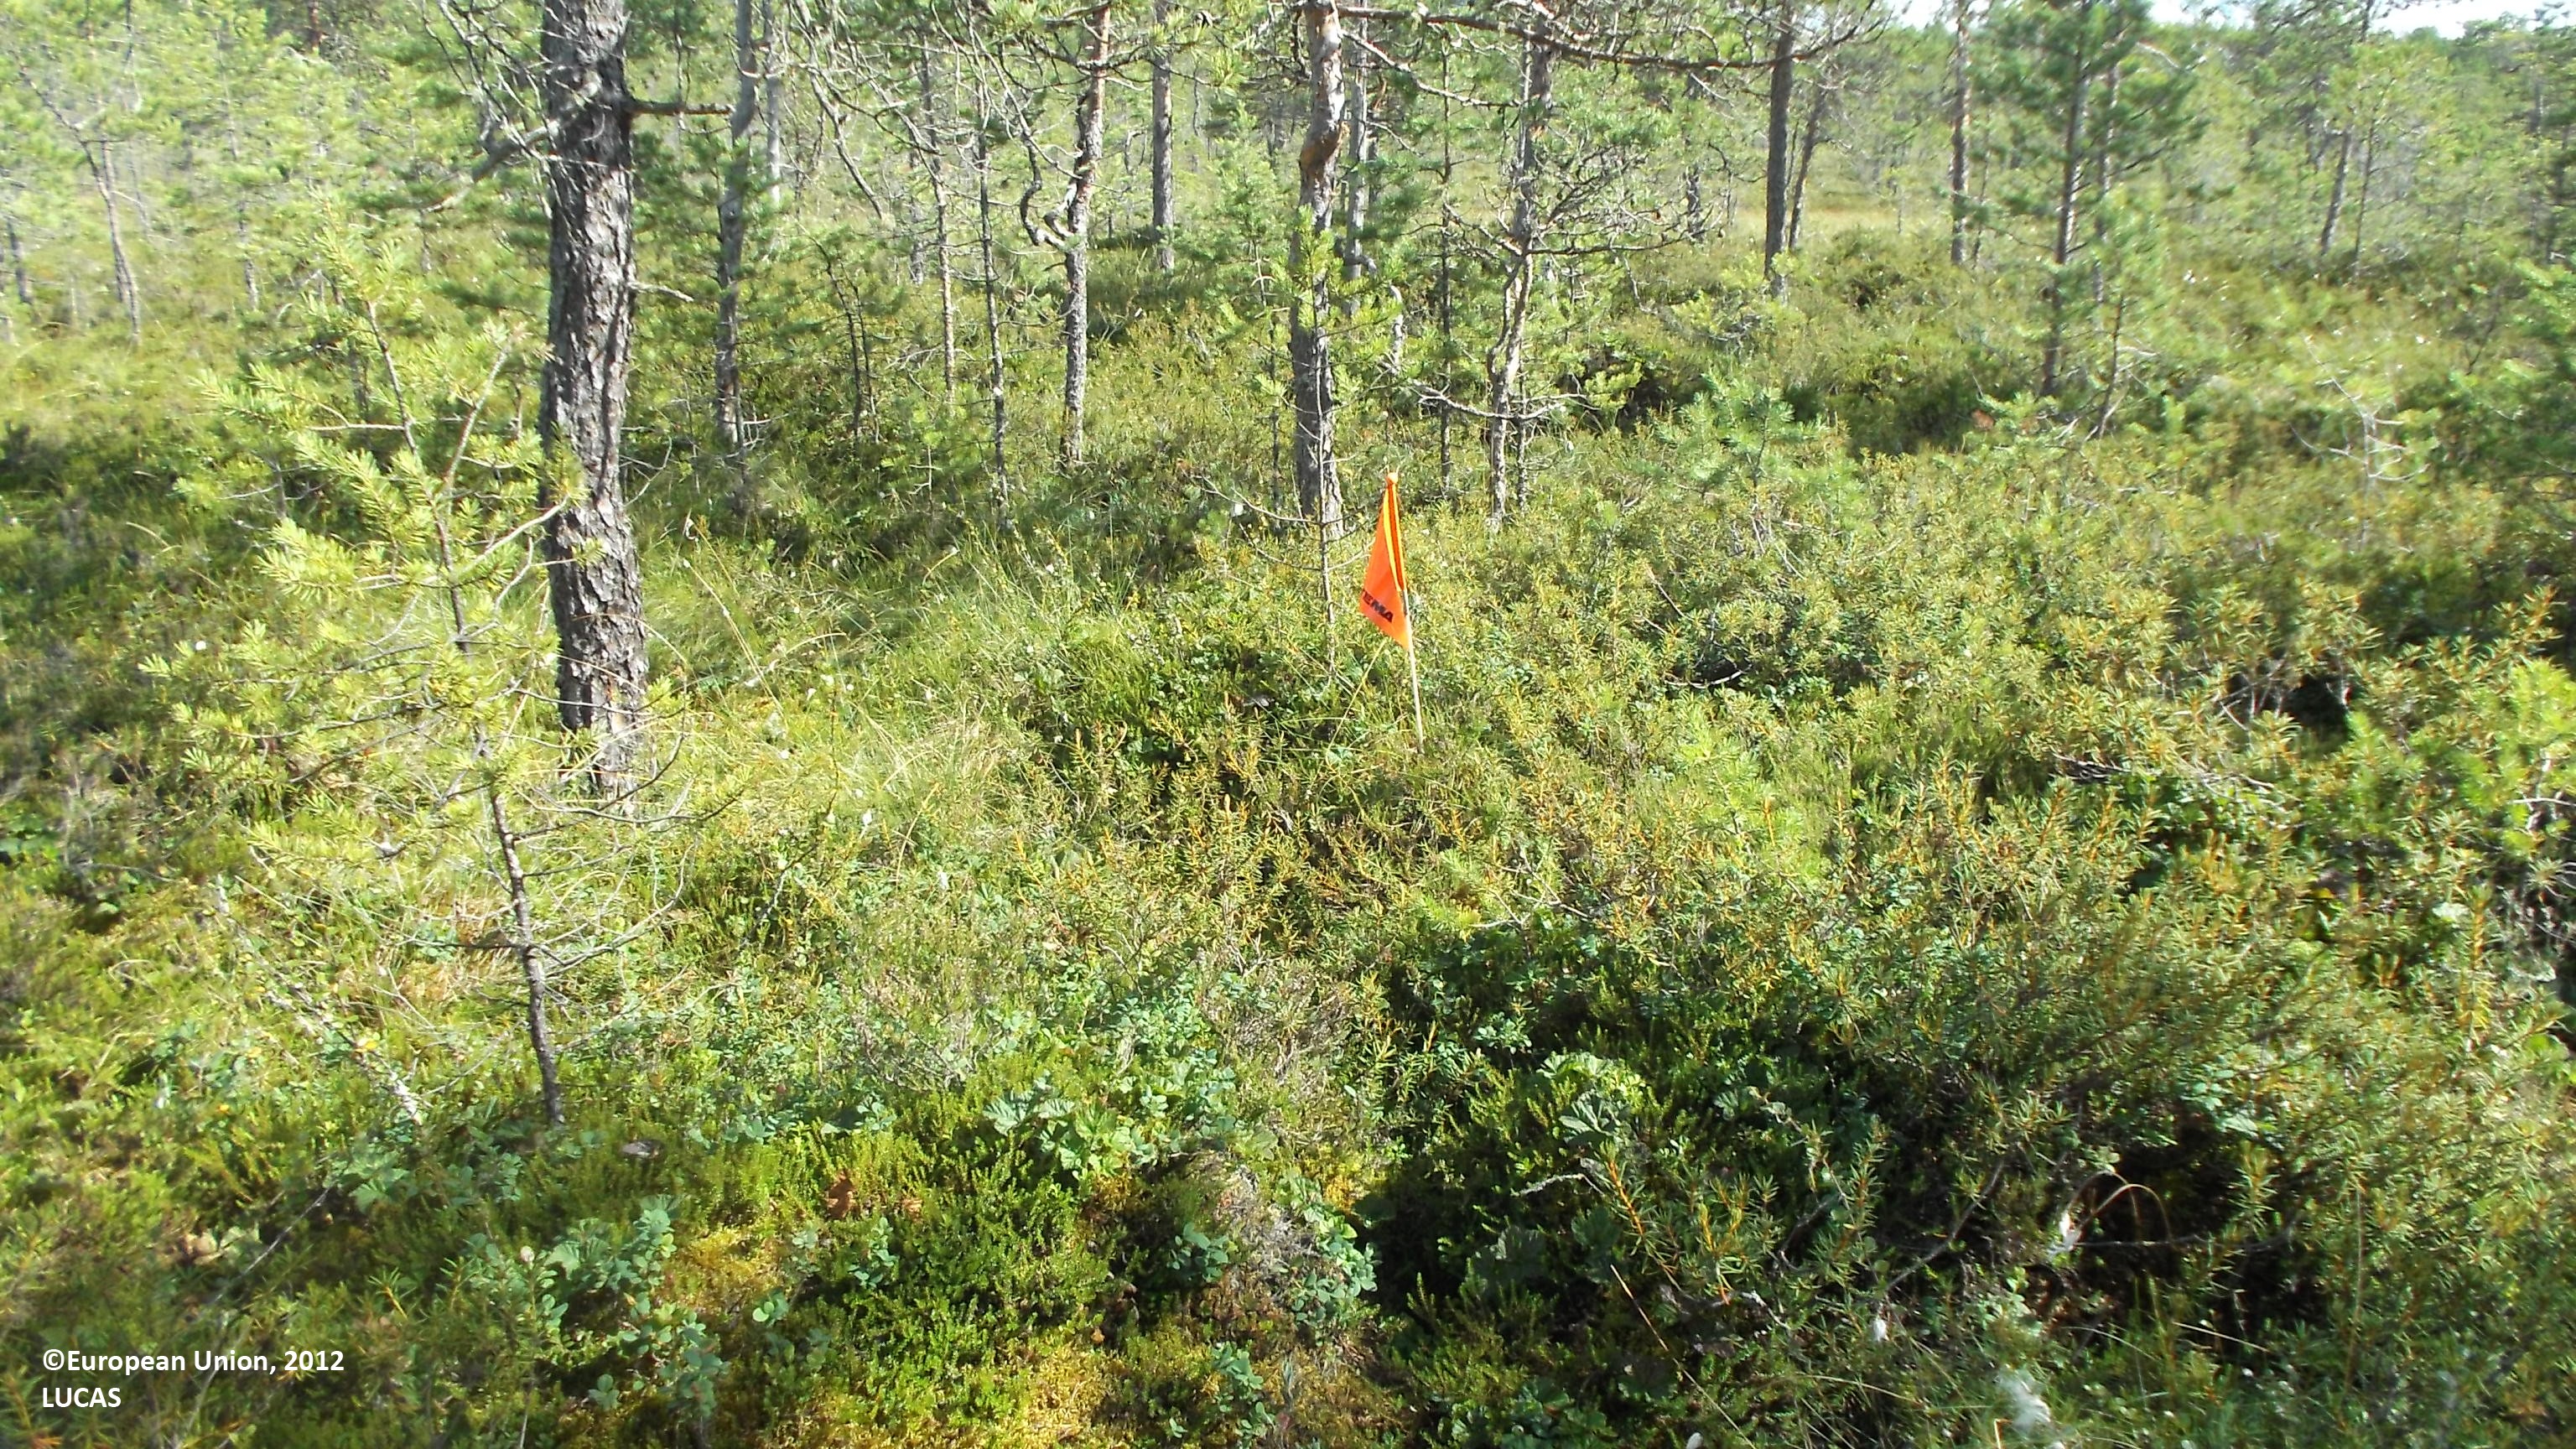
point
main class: Woodland
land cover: Pine dominated coniferous woodland
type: mire and swamp forests
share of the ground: 10 - 25 %
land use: Semi-natural and natural areas not in use
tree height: > 5 m
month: August
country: FI
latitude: 63.9427
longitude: 23.5454
